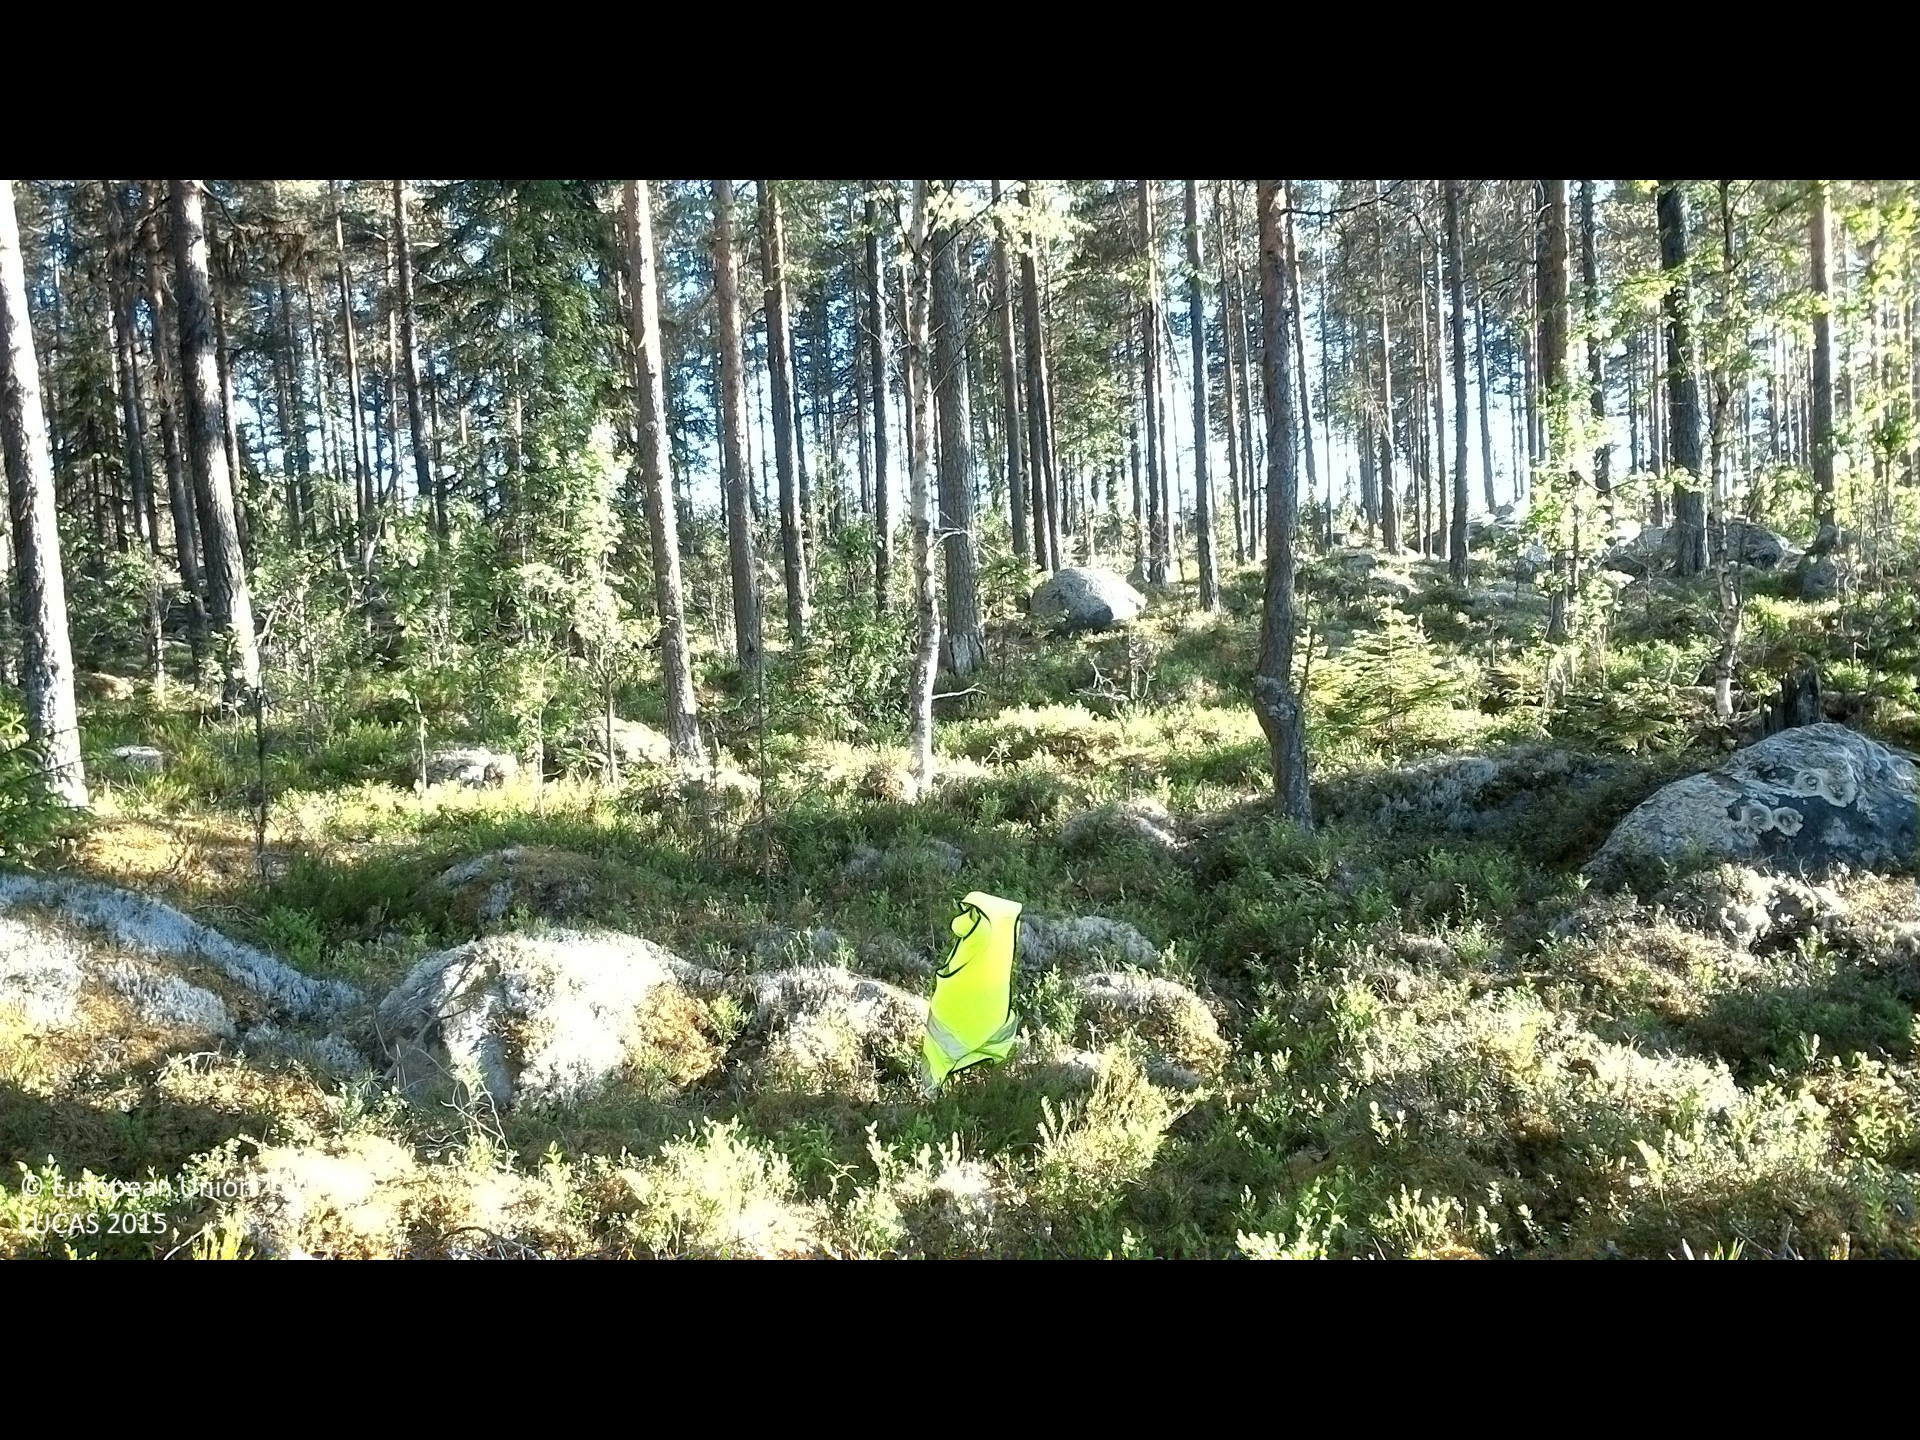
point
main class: Woodland
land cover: Pine dominated coniferous woodland
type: boreal forest
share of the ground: 25 - 50 %
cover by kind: coniferous forest trees 40 %, shrubs 30 %, lichens and mosses 25 %, broadleaved forest trees 5 %
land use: Forestry
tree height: > 5 m
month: June
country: SE
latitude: 62.0405
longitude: 16.0040
